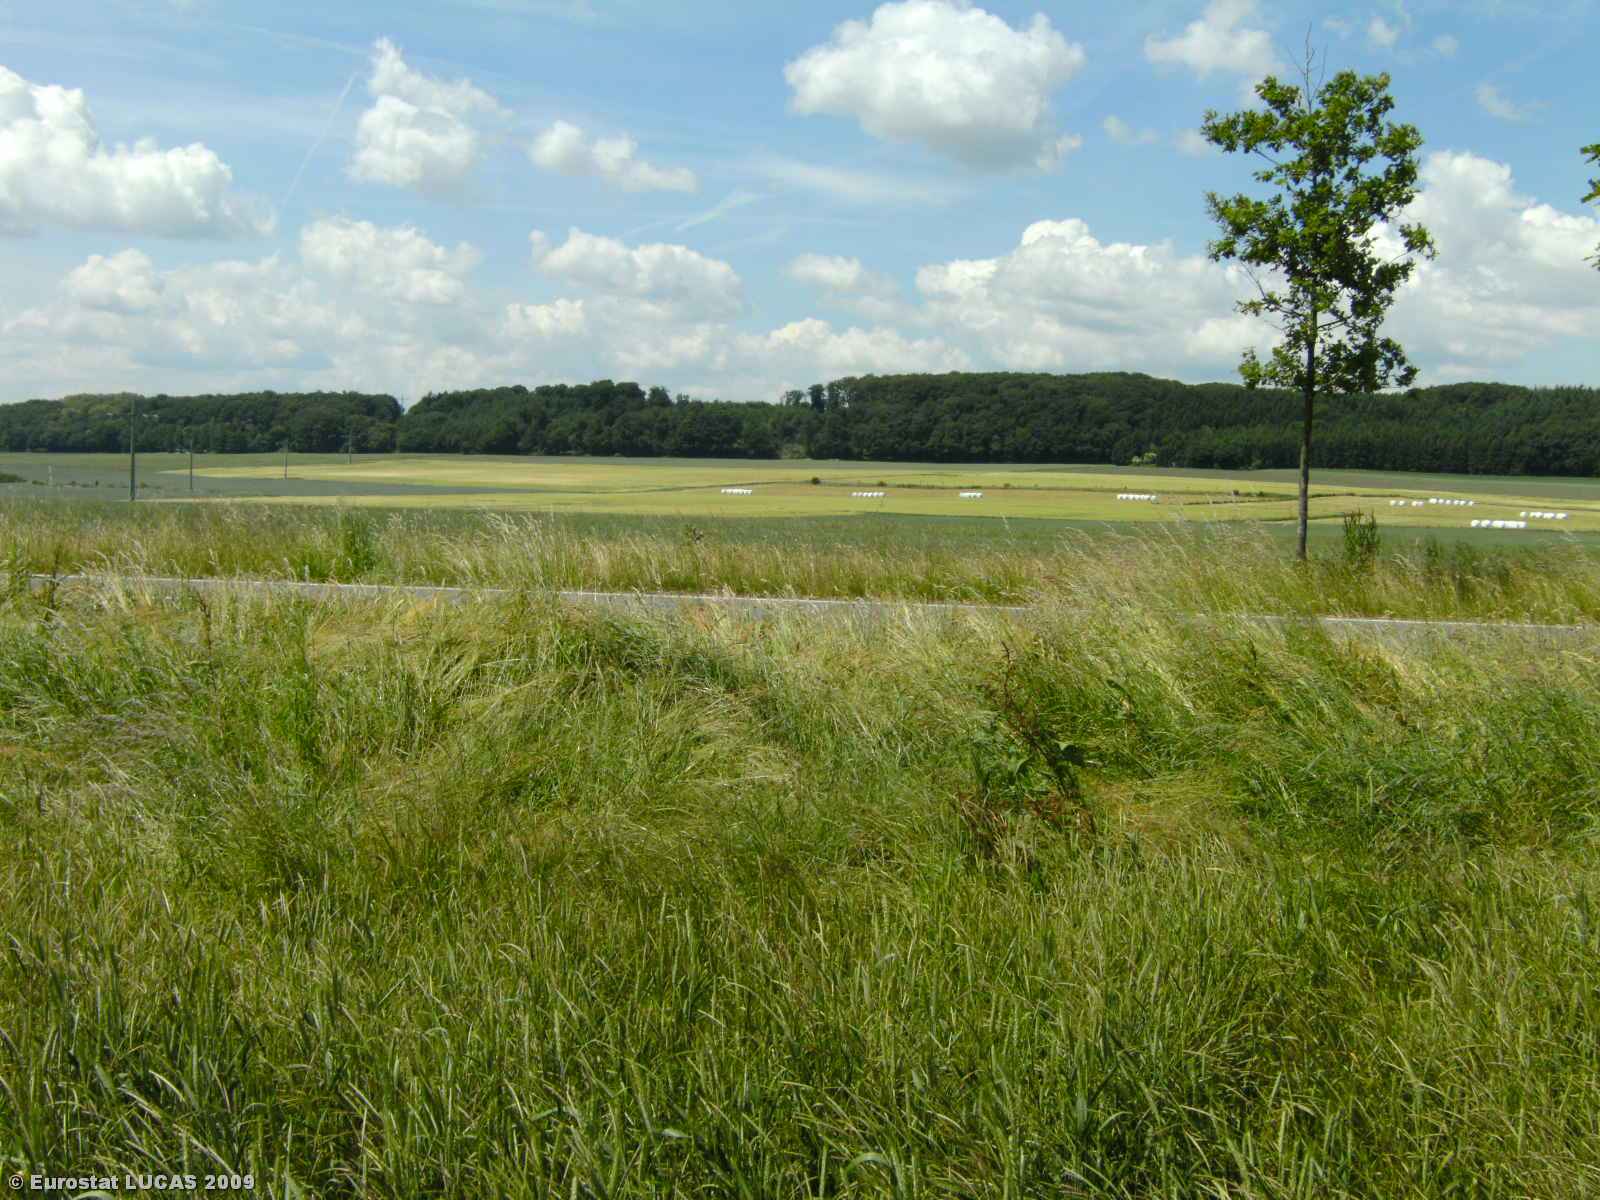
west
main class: Cropland
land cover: Rye
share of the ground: > 75 %
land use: Agriculture (excluding fallow land and kitchen gardens)
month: June
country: LU
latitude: 49.5296
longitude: 6.2830
